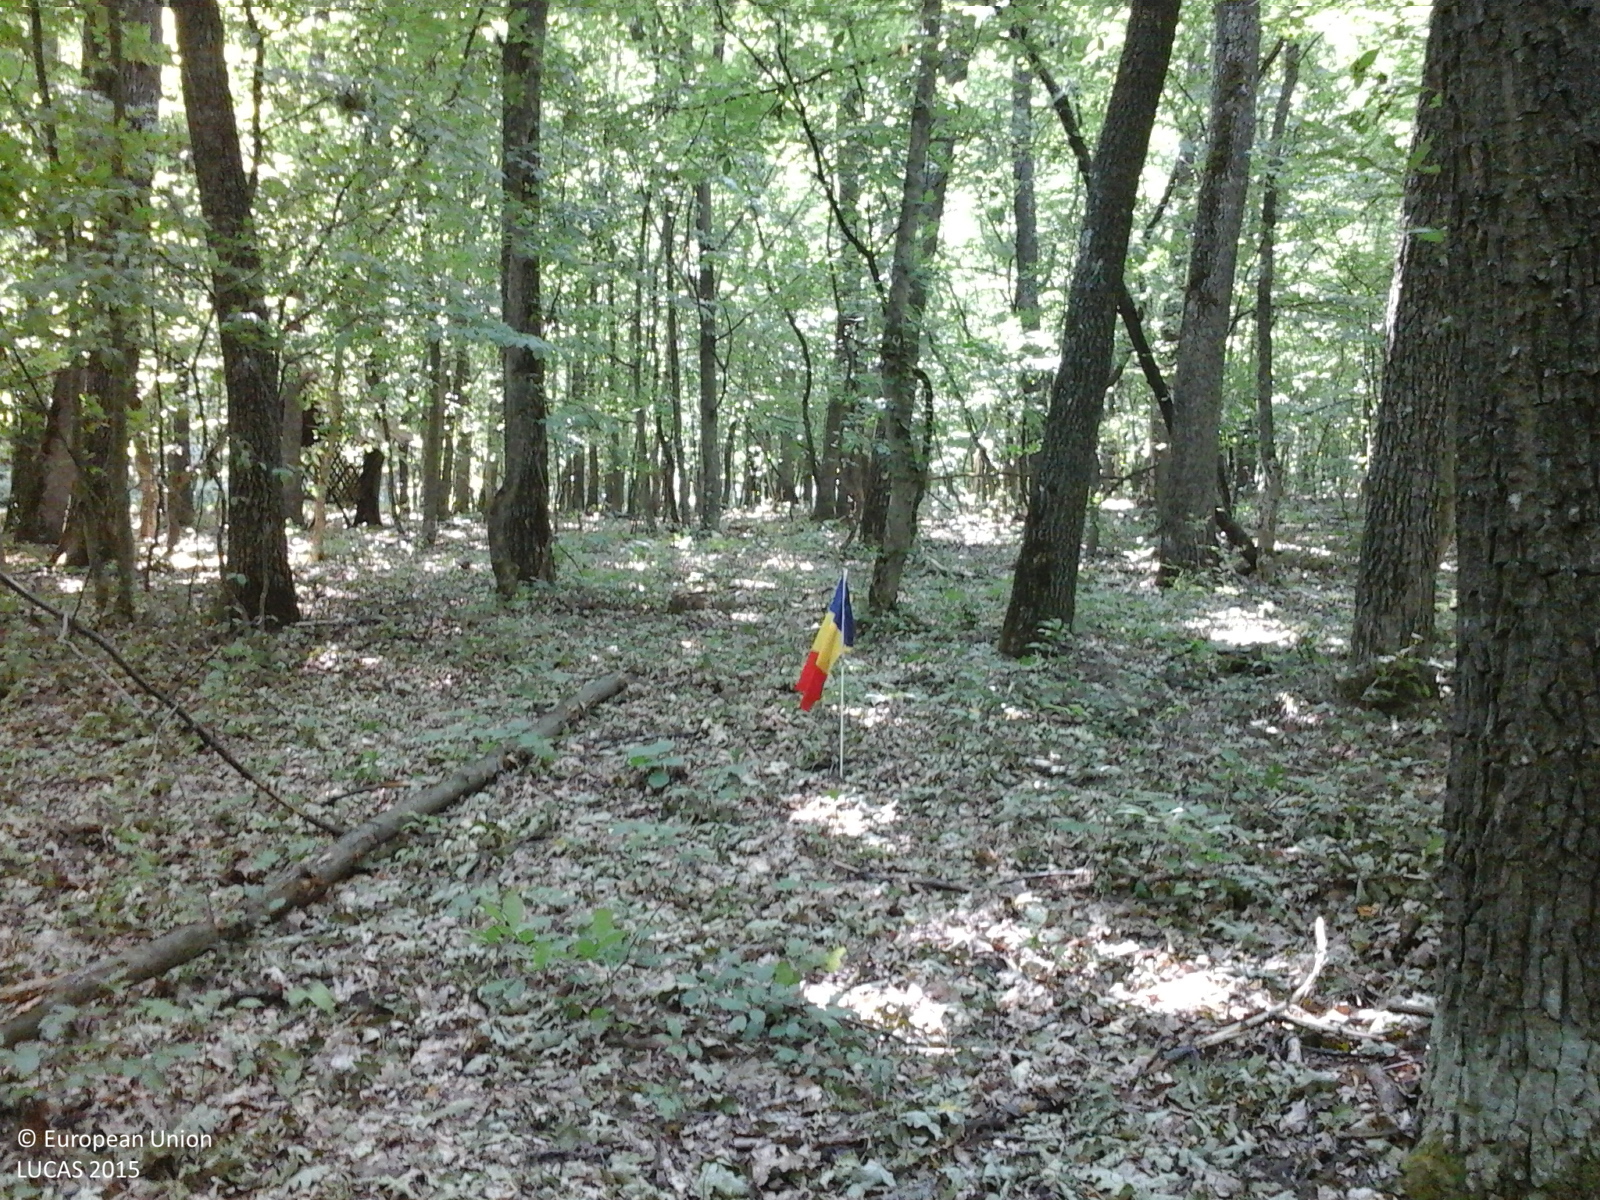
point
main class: Woodland
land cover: Broadleaved woodland
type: mesophytic deciduous forest
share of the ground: > 75 %
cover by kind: broadleaved forest trees 95 %, herbaceous plants 5 %
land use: Forestry
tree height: > 5 m
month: June
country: RO
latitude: 46.8794
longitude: 27.9606
